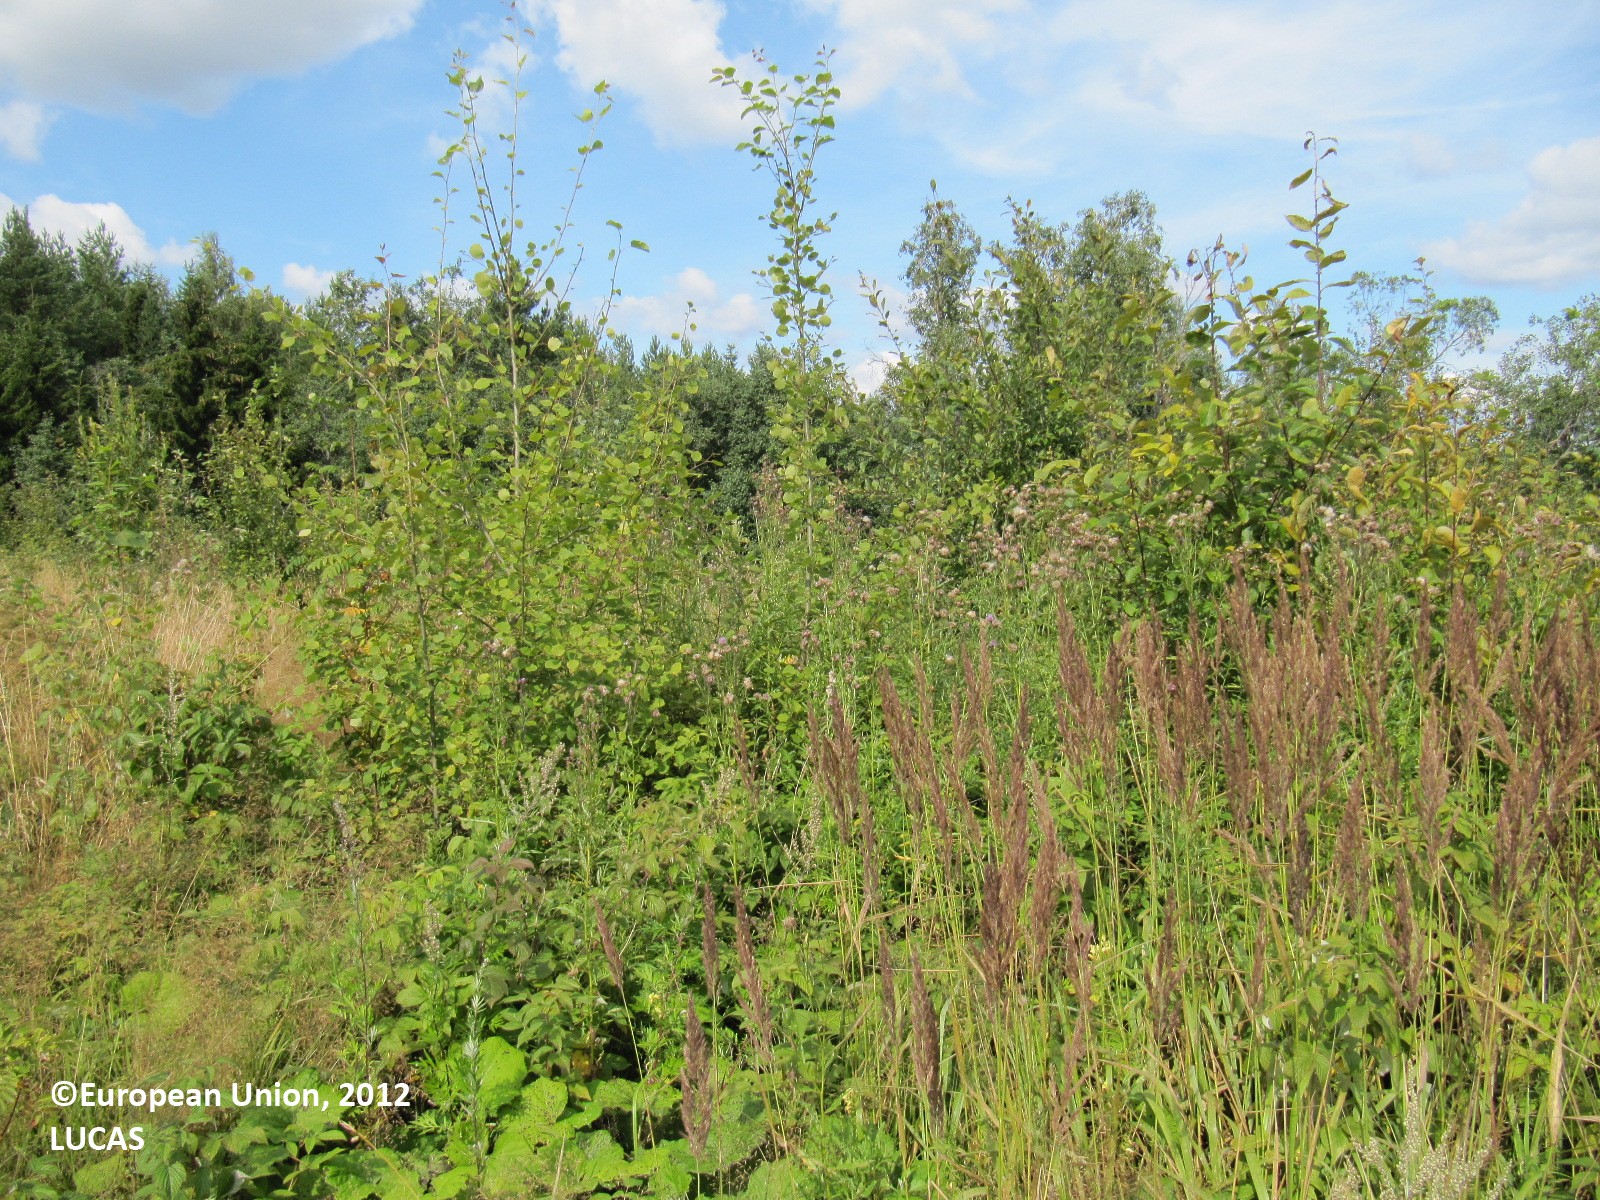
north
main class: Grassland
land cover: Grassland with sparse tree/shrub cover
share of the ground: > 75 %
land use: Semi-natural and natural areas not in use
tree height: < 5 m
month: August
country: FI
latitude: 60.3815
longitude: 24.3063
